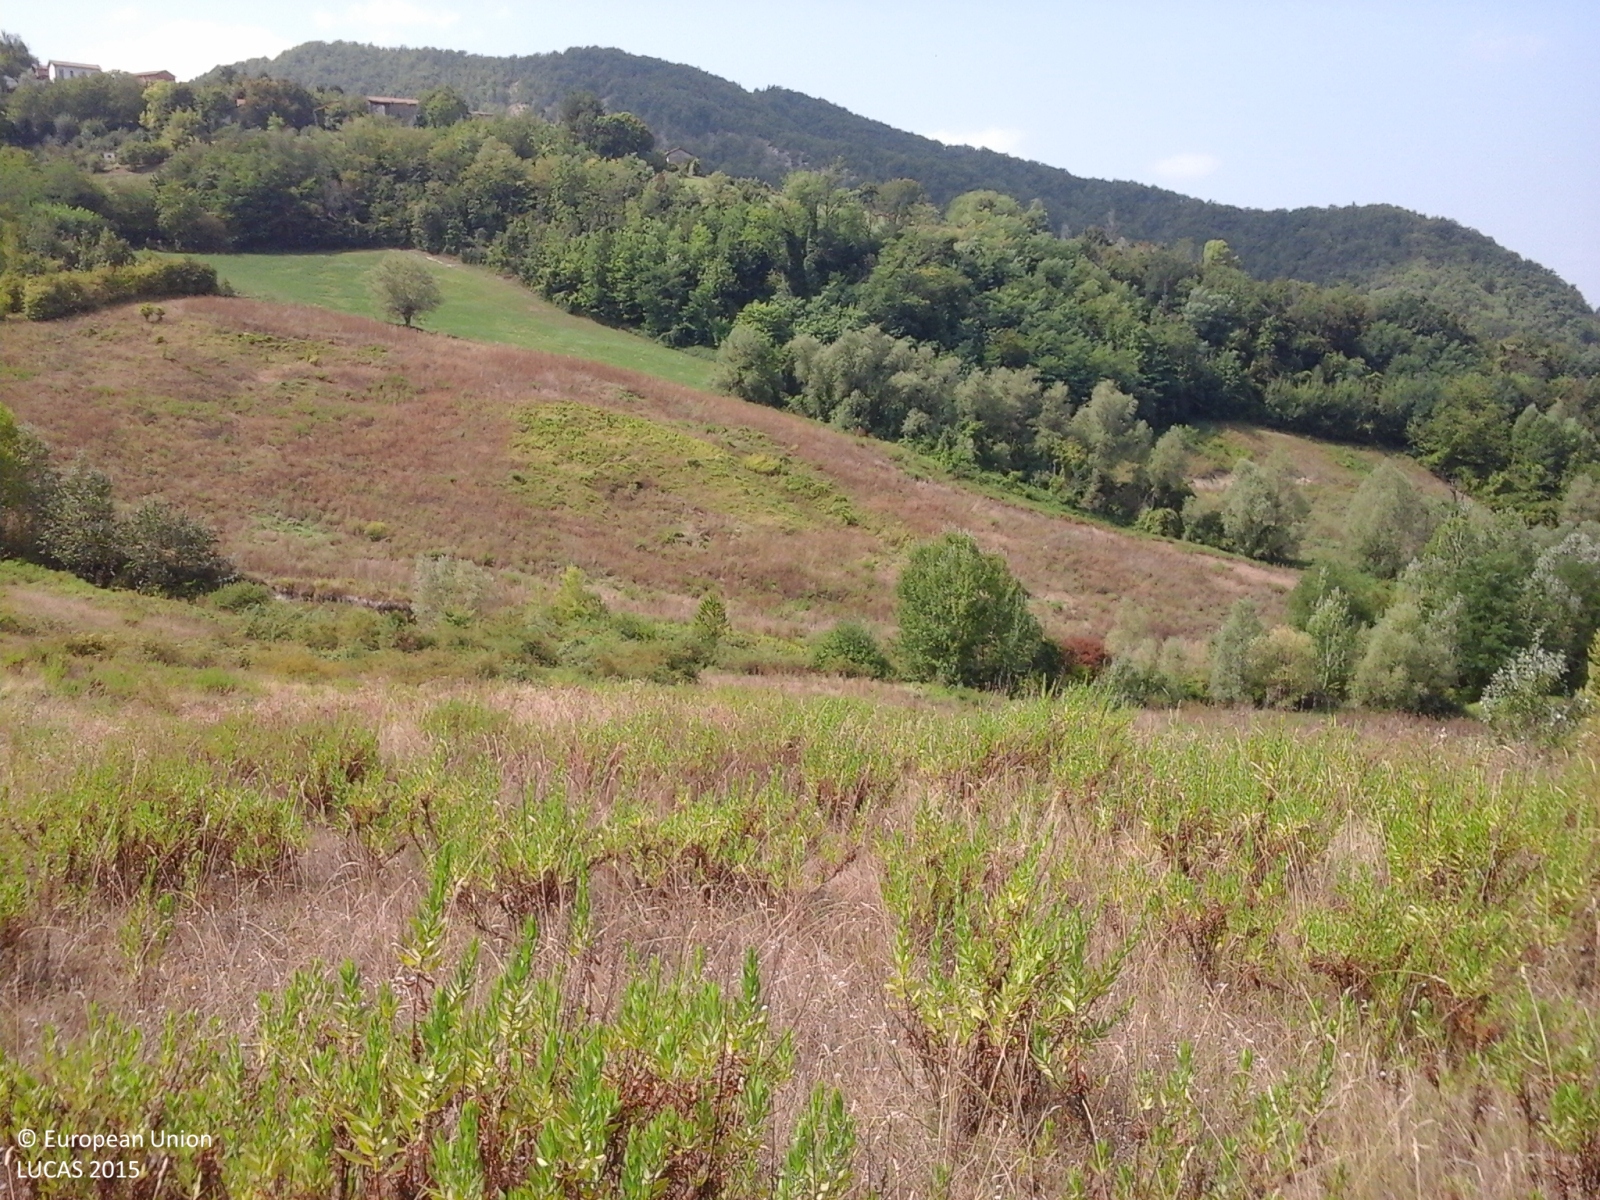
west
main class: Grassland
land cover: Grassland without tree/shrub cover
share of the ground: > 75 %
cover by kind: herbaceous plants 100 %
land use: Semi-natural and natural areas not in use
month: August
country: IT
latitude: 44.8877
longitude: 9.1029
